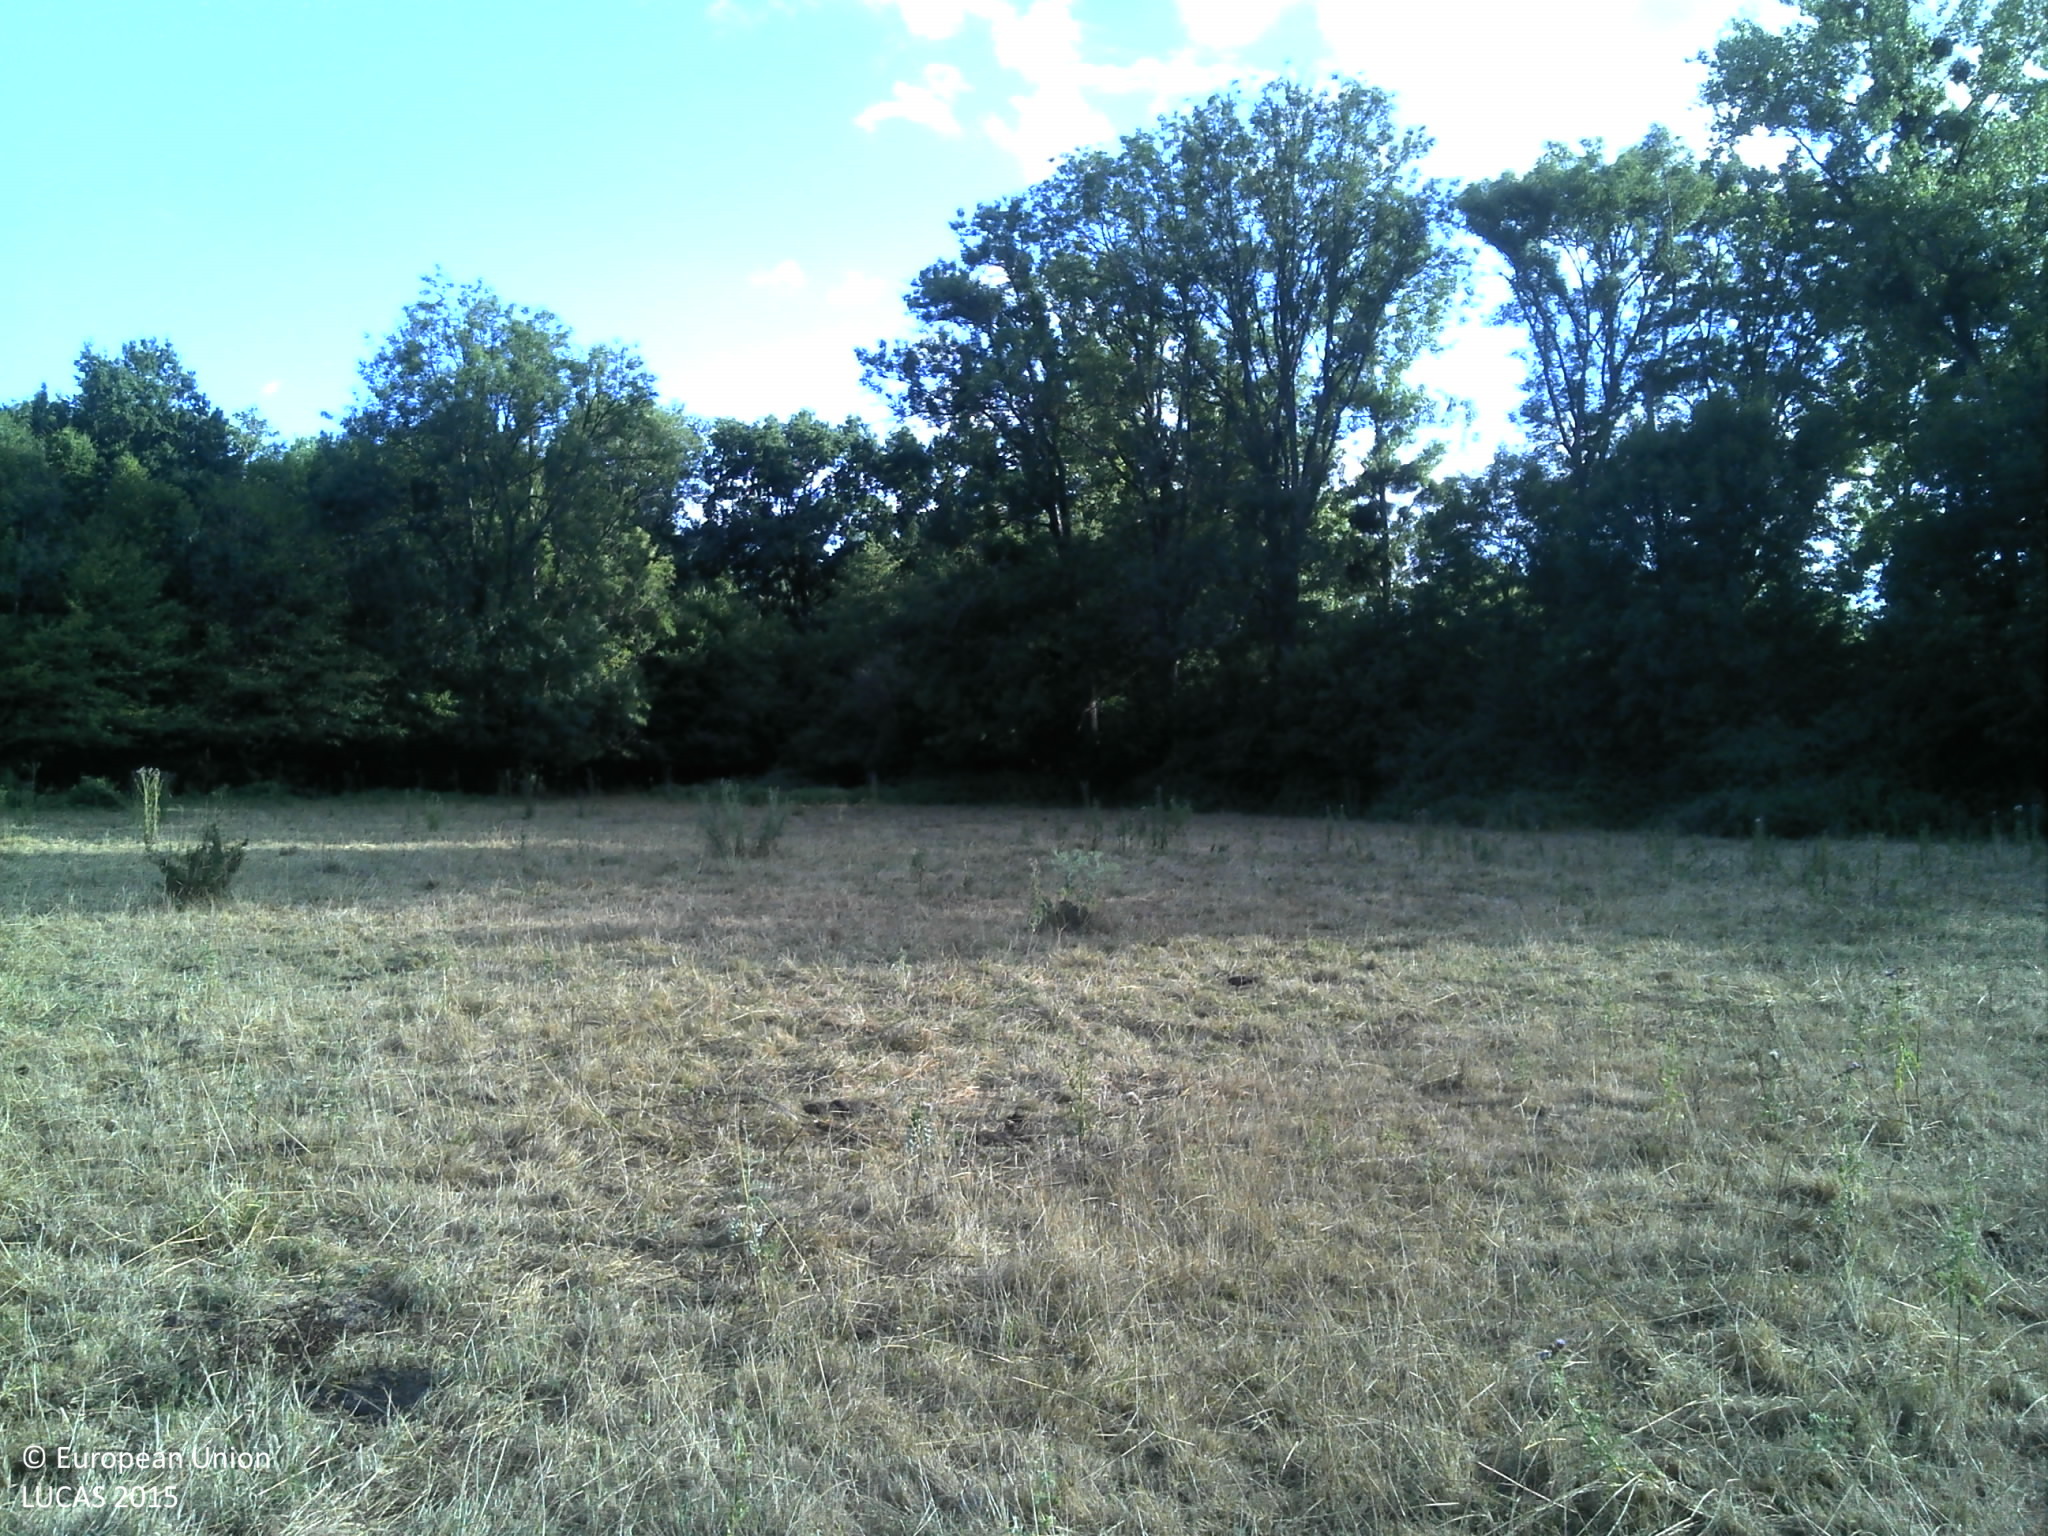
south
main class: Grassland
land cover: Grassland without tree/shrub cover
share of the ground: > 75 %
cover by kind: herbaceous plants 100 %
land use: Agriculture (excluding fallow land and kitchen gardens)
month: July
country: FR
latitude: 45.8282
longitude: 4.1195
